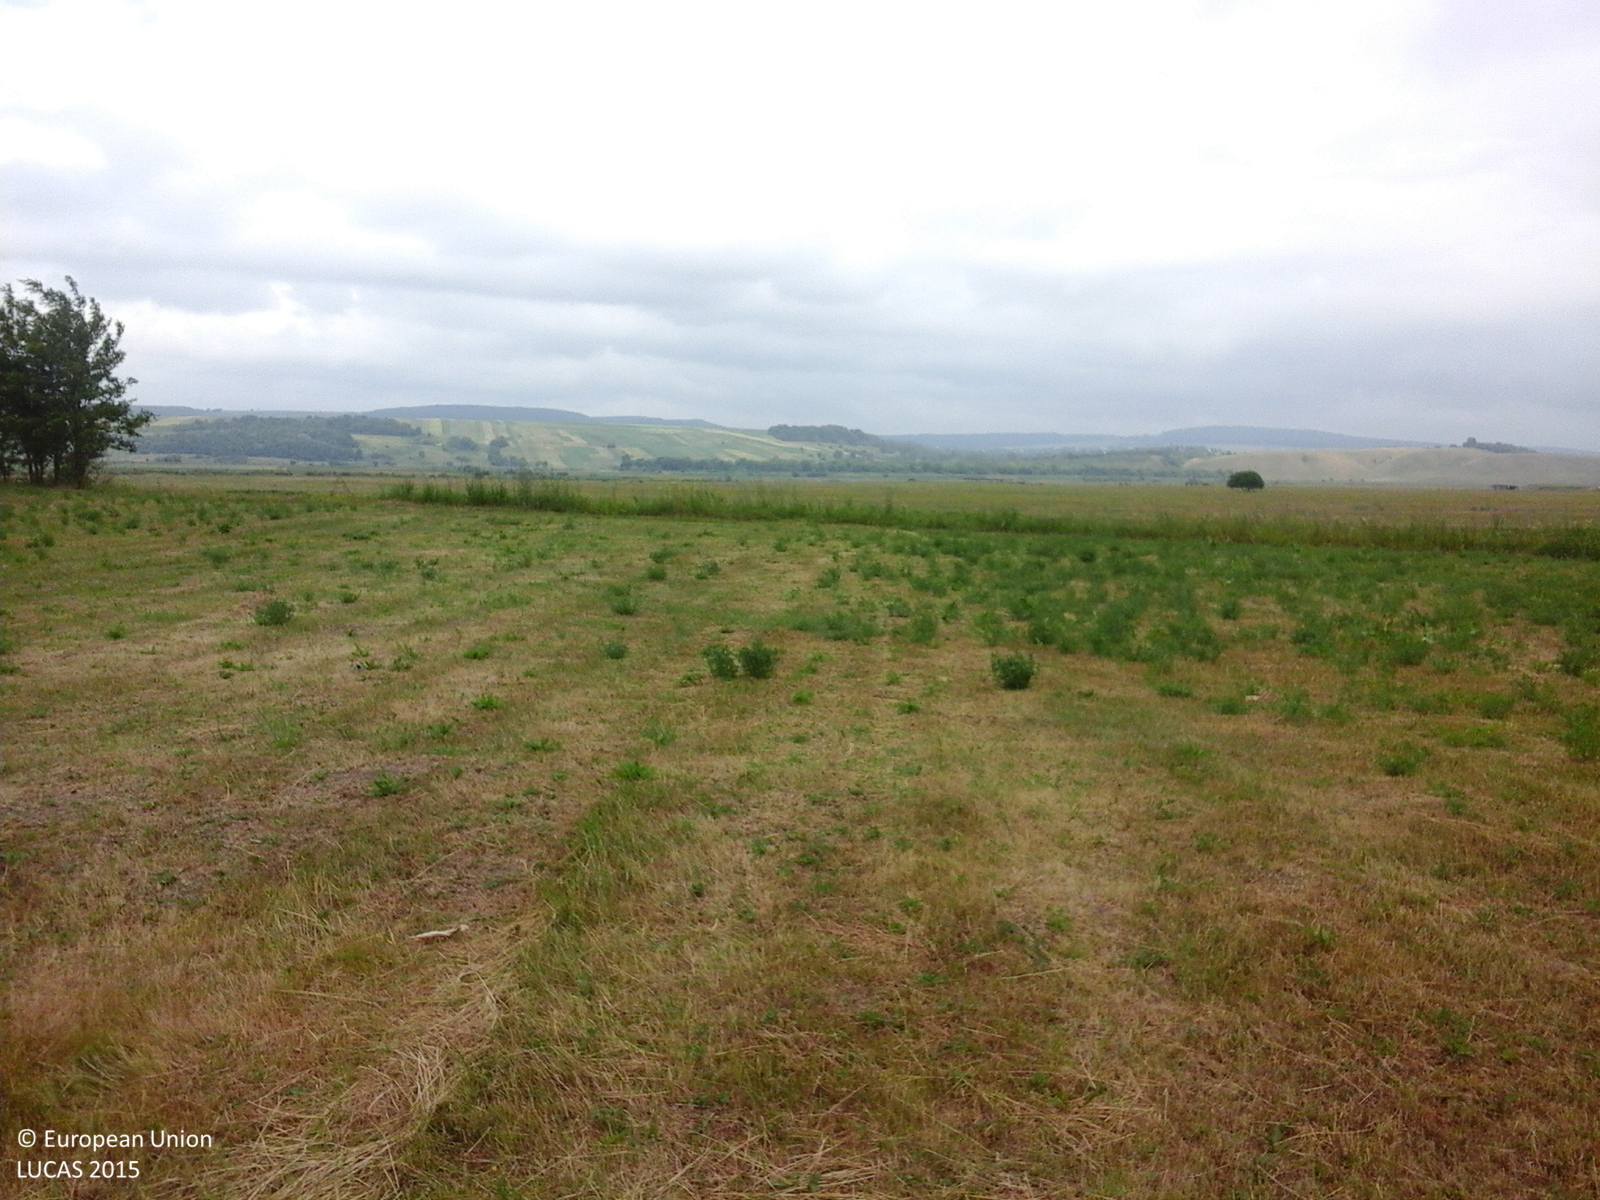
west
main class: Cropland
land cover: Other leguminous and mixtures for fodder
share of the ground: > 75 %
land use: Agriculture (excluding fallow land and kitchen gardens)
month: June
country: RO
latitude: 47.3627
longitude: 26.6838
